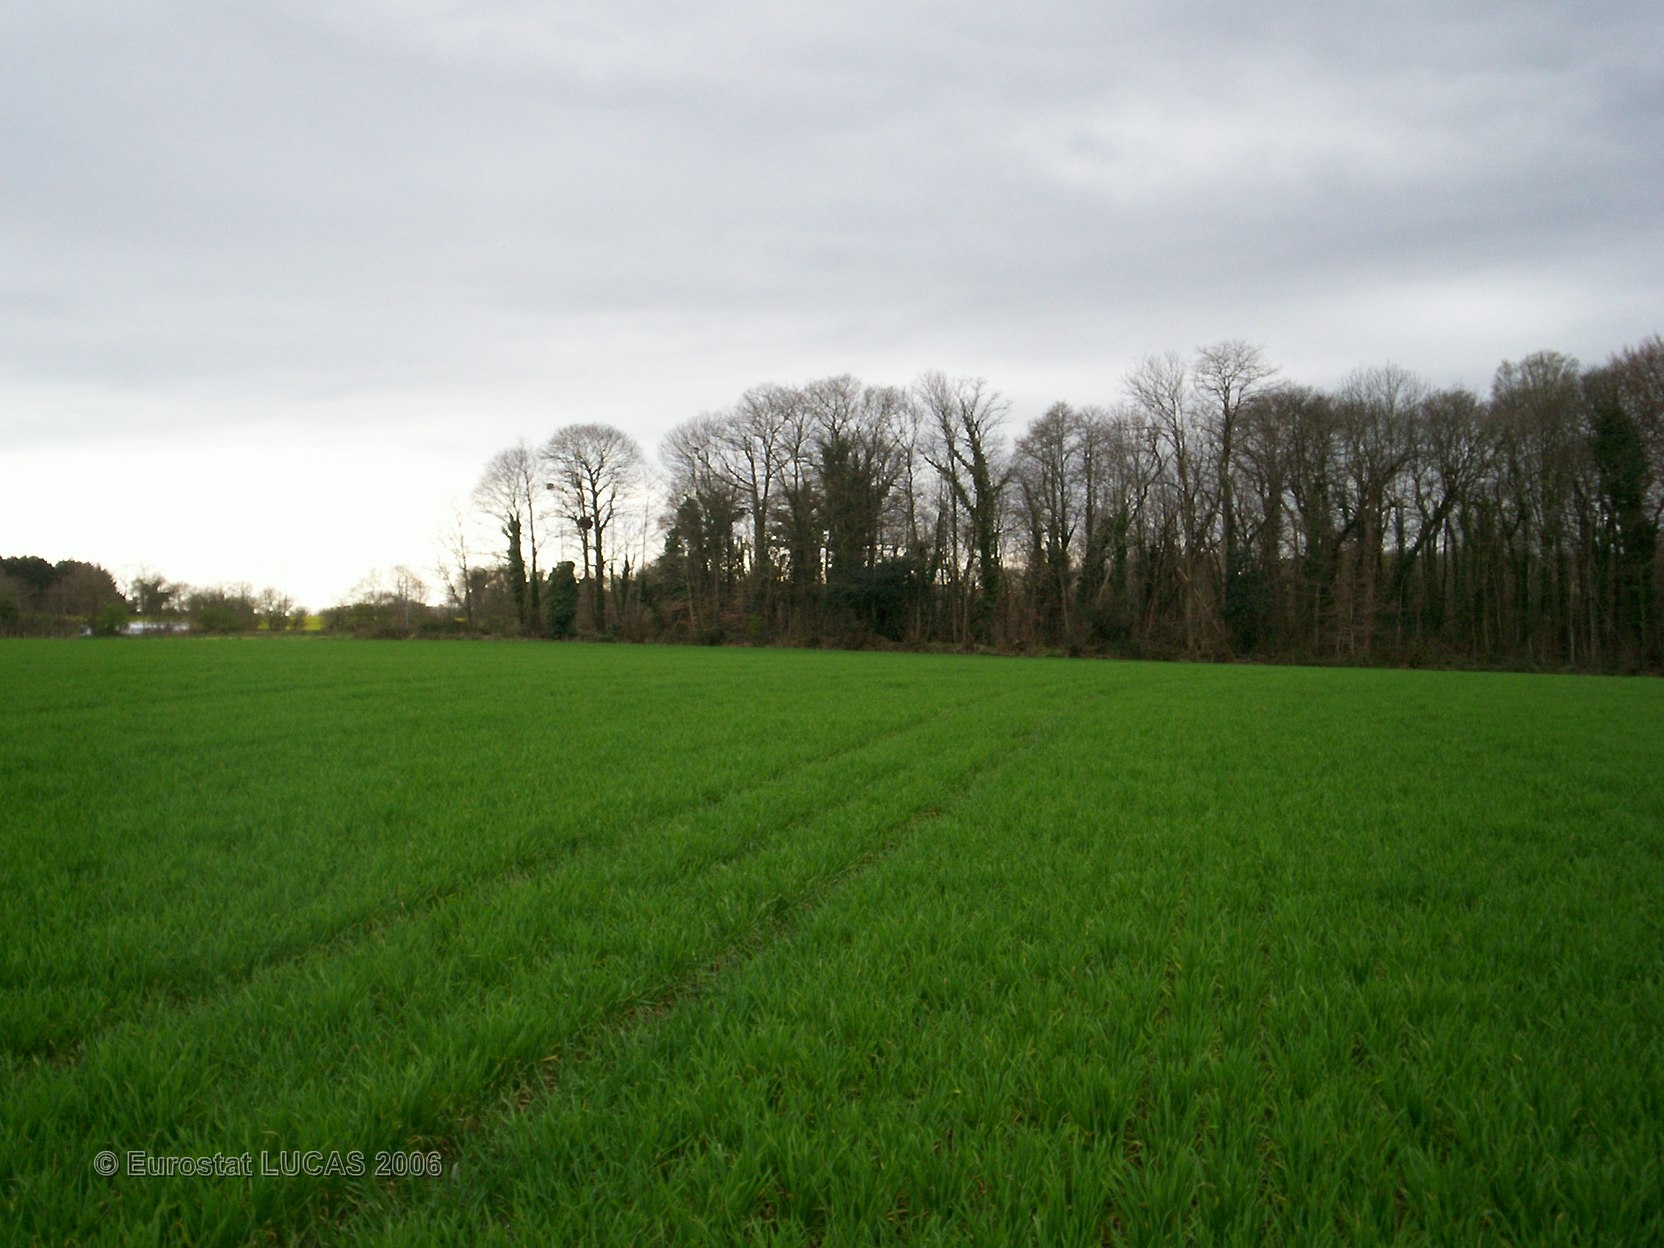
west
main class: Cropland
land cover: Common wheat
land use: Agriculture (excluding fallow land and kitchen gardens)
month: April
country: FR
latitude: 47.8295
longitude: -3.4740
